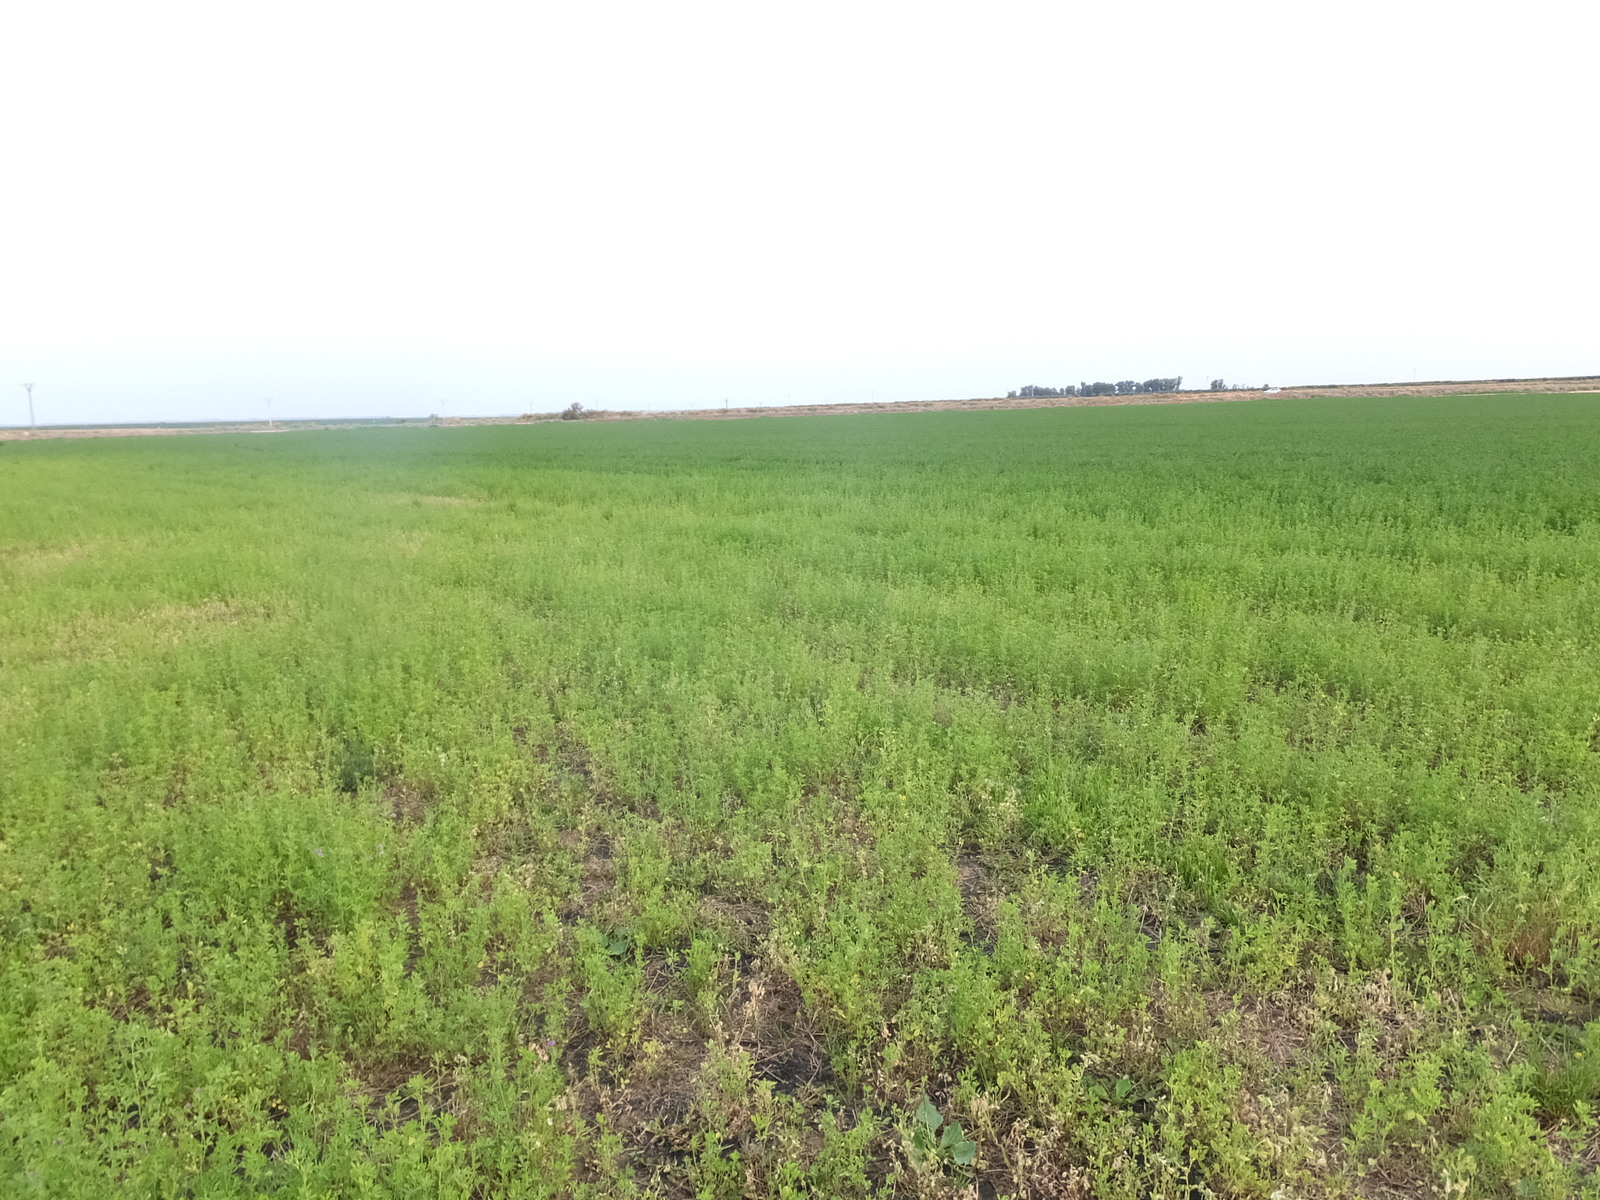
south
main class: Cropland
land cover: Lucerne
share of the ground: > 75 %
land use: Agriculture (excluding fallow land and kitchen gardens)
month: July
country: ES
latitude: 41.7717
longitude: 0.3250
